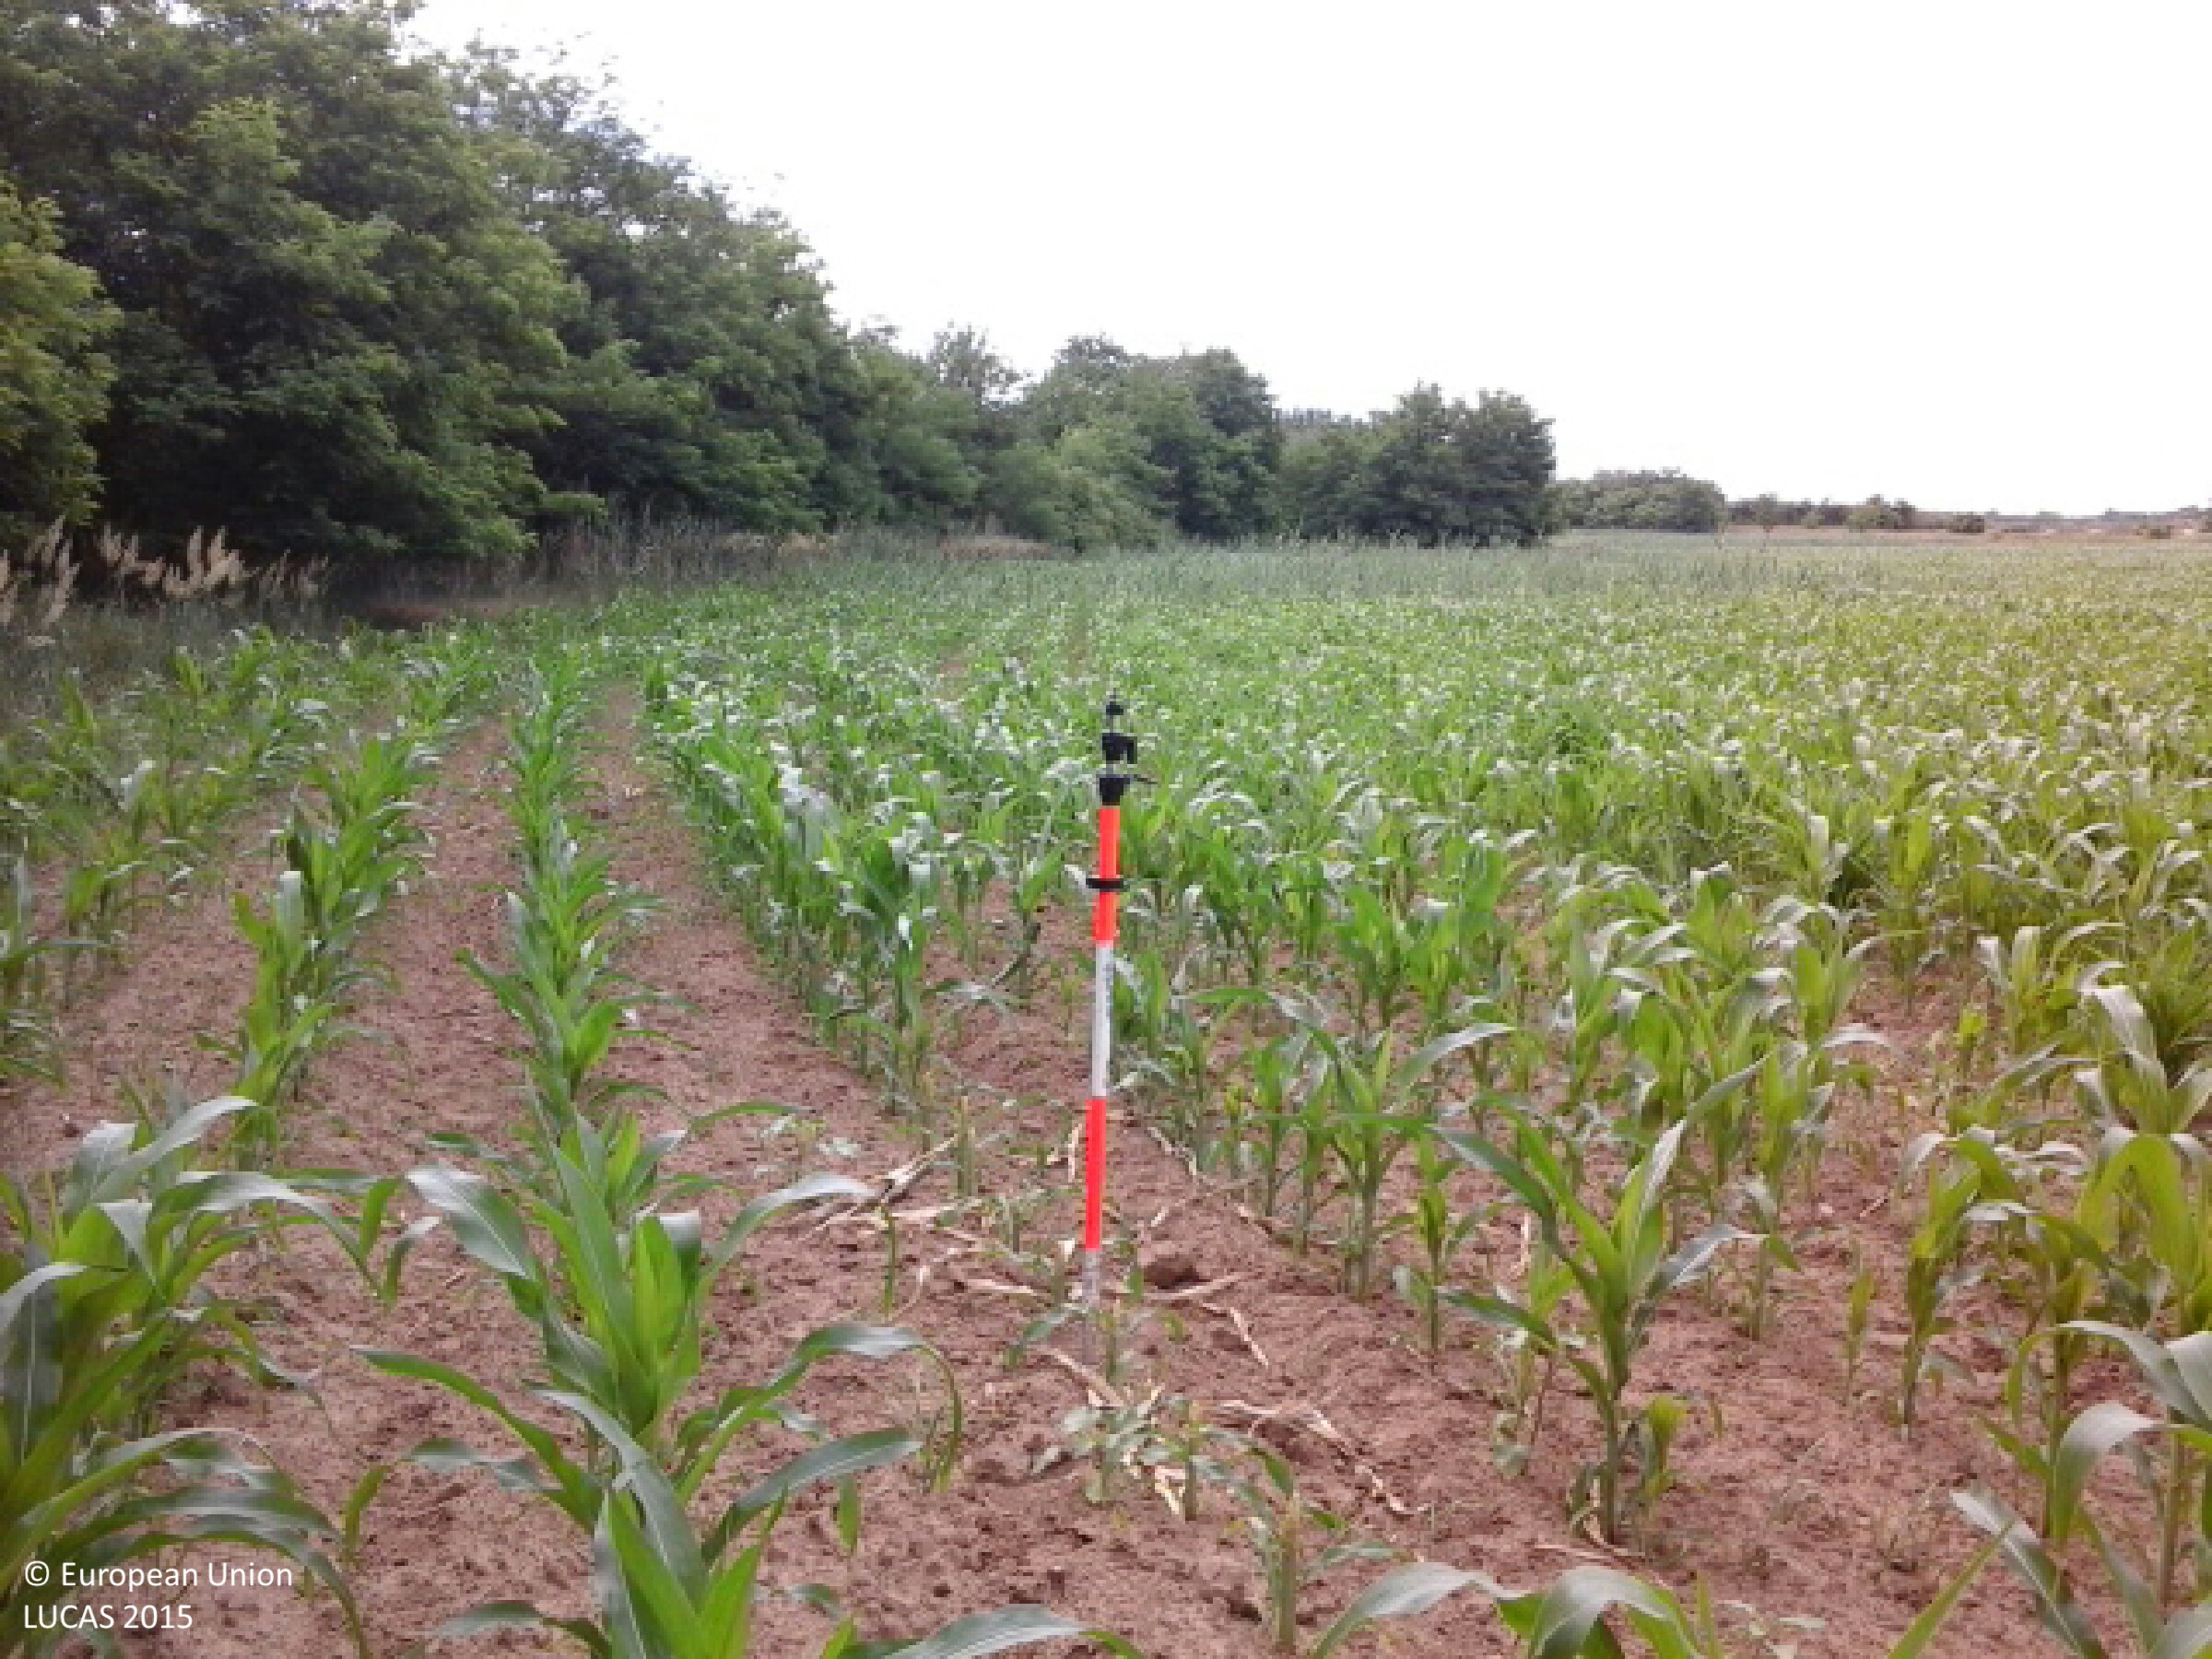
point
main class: Cropland
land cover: Maize
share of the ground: 10 - 25 %
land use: Agriculture (excluding fallow land and kitchen gardens)
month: June
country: HU
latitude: 48.0079
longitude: 21.7780
